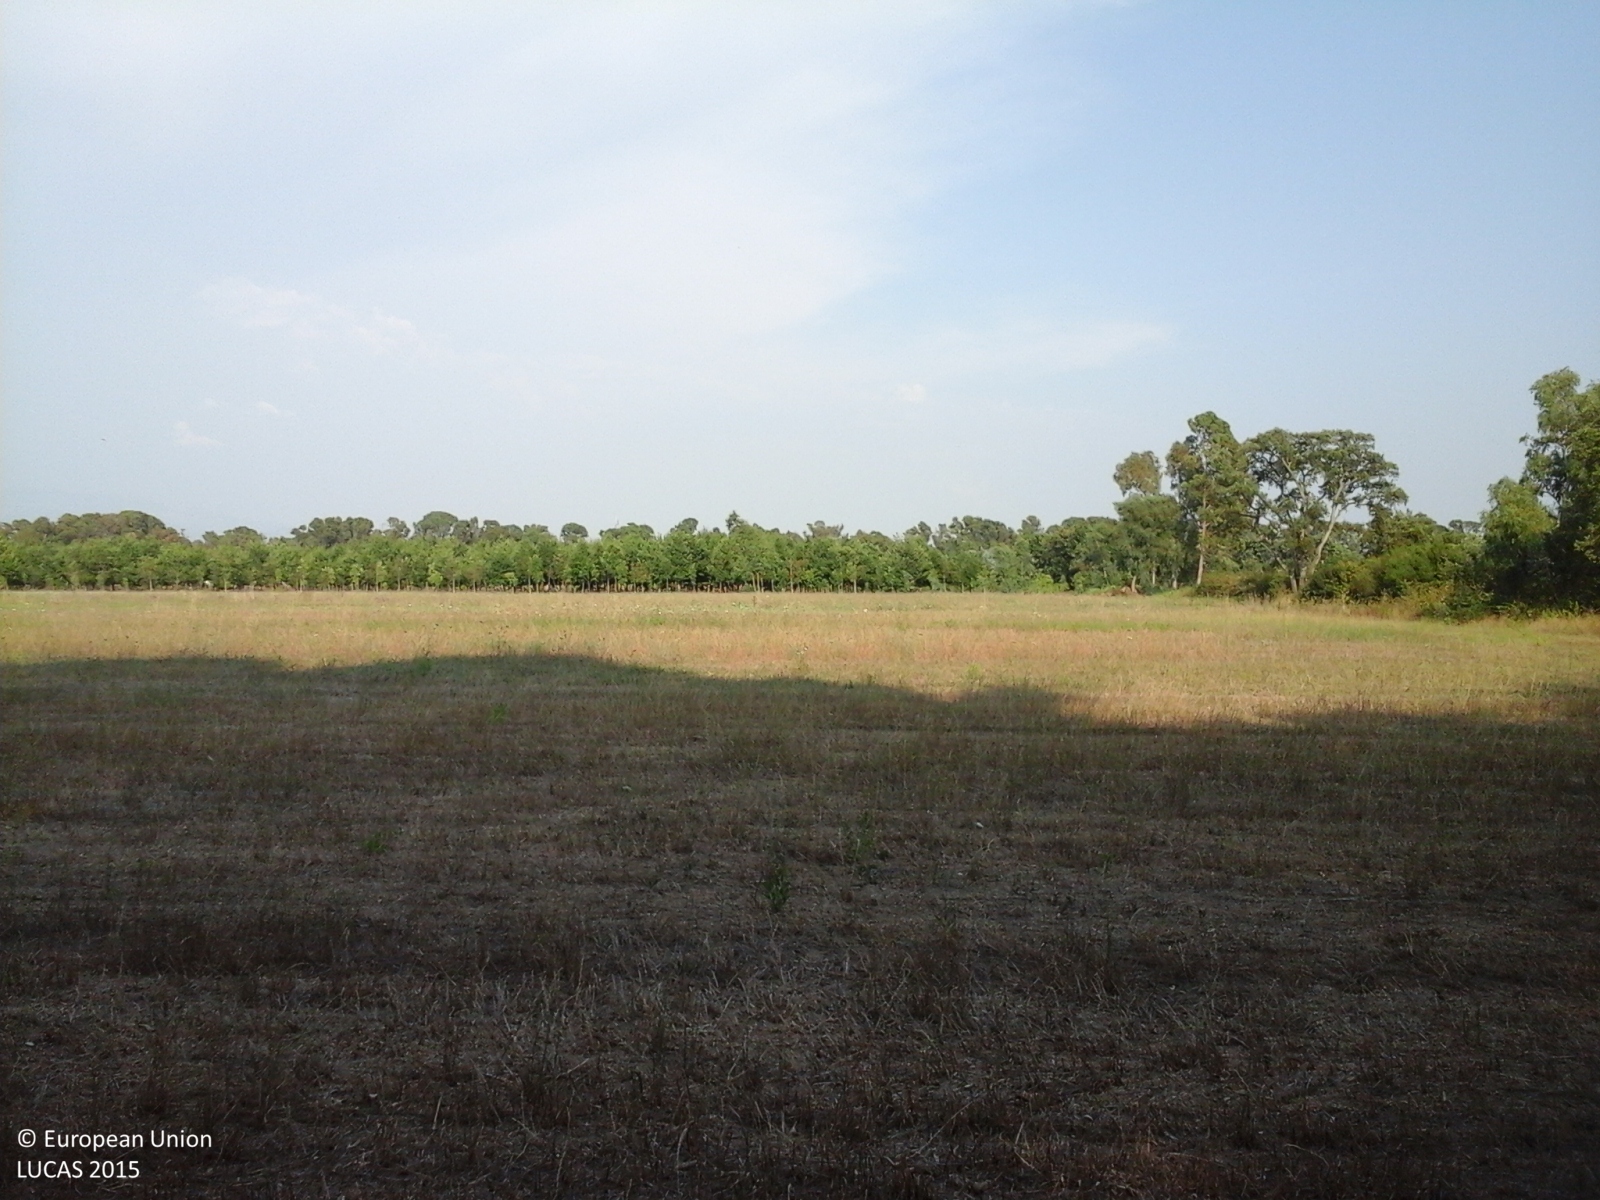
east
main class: Cropland
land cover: Temporary grasslands
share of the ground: > 75 %
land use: Agriculture (excluding fallow land and kitchen gardens)
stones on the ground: < 10 %
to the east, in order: Temporary grasslands; Ditches and canals; Temporary grasslands; Ditches and canals; Temporary grasslands; Ditches and canals; Temporary grasslands; Ditches and canals; Broadleaved woodland; Ditches and canals; Broadleaved woodland
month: July
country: IT
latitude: 41.4762
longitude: 12.8029
